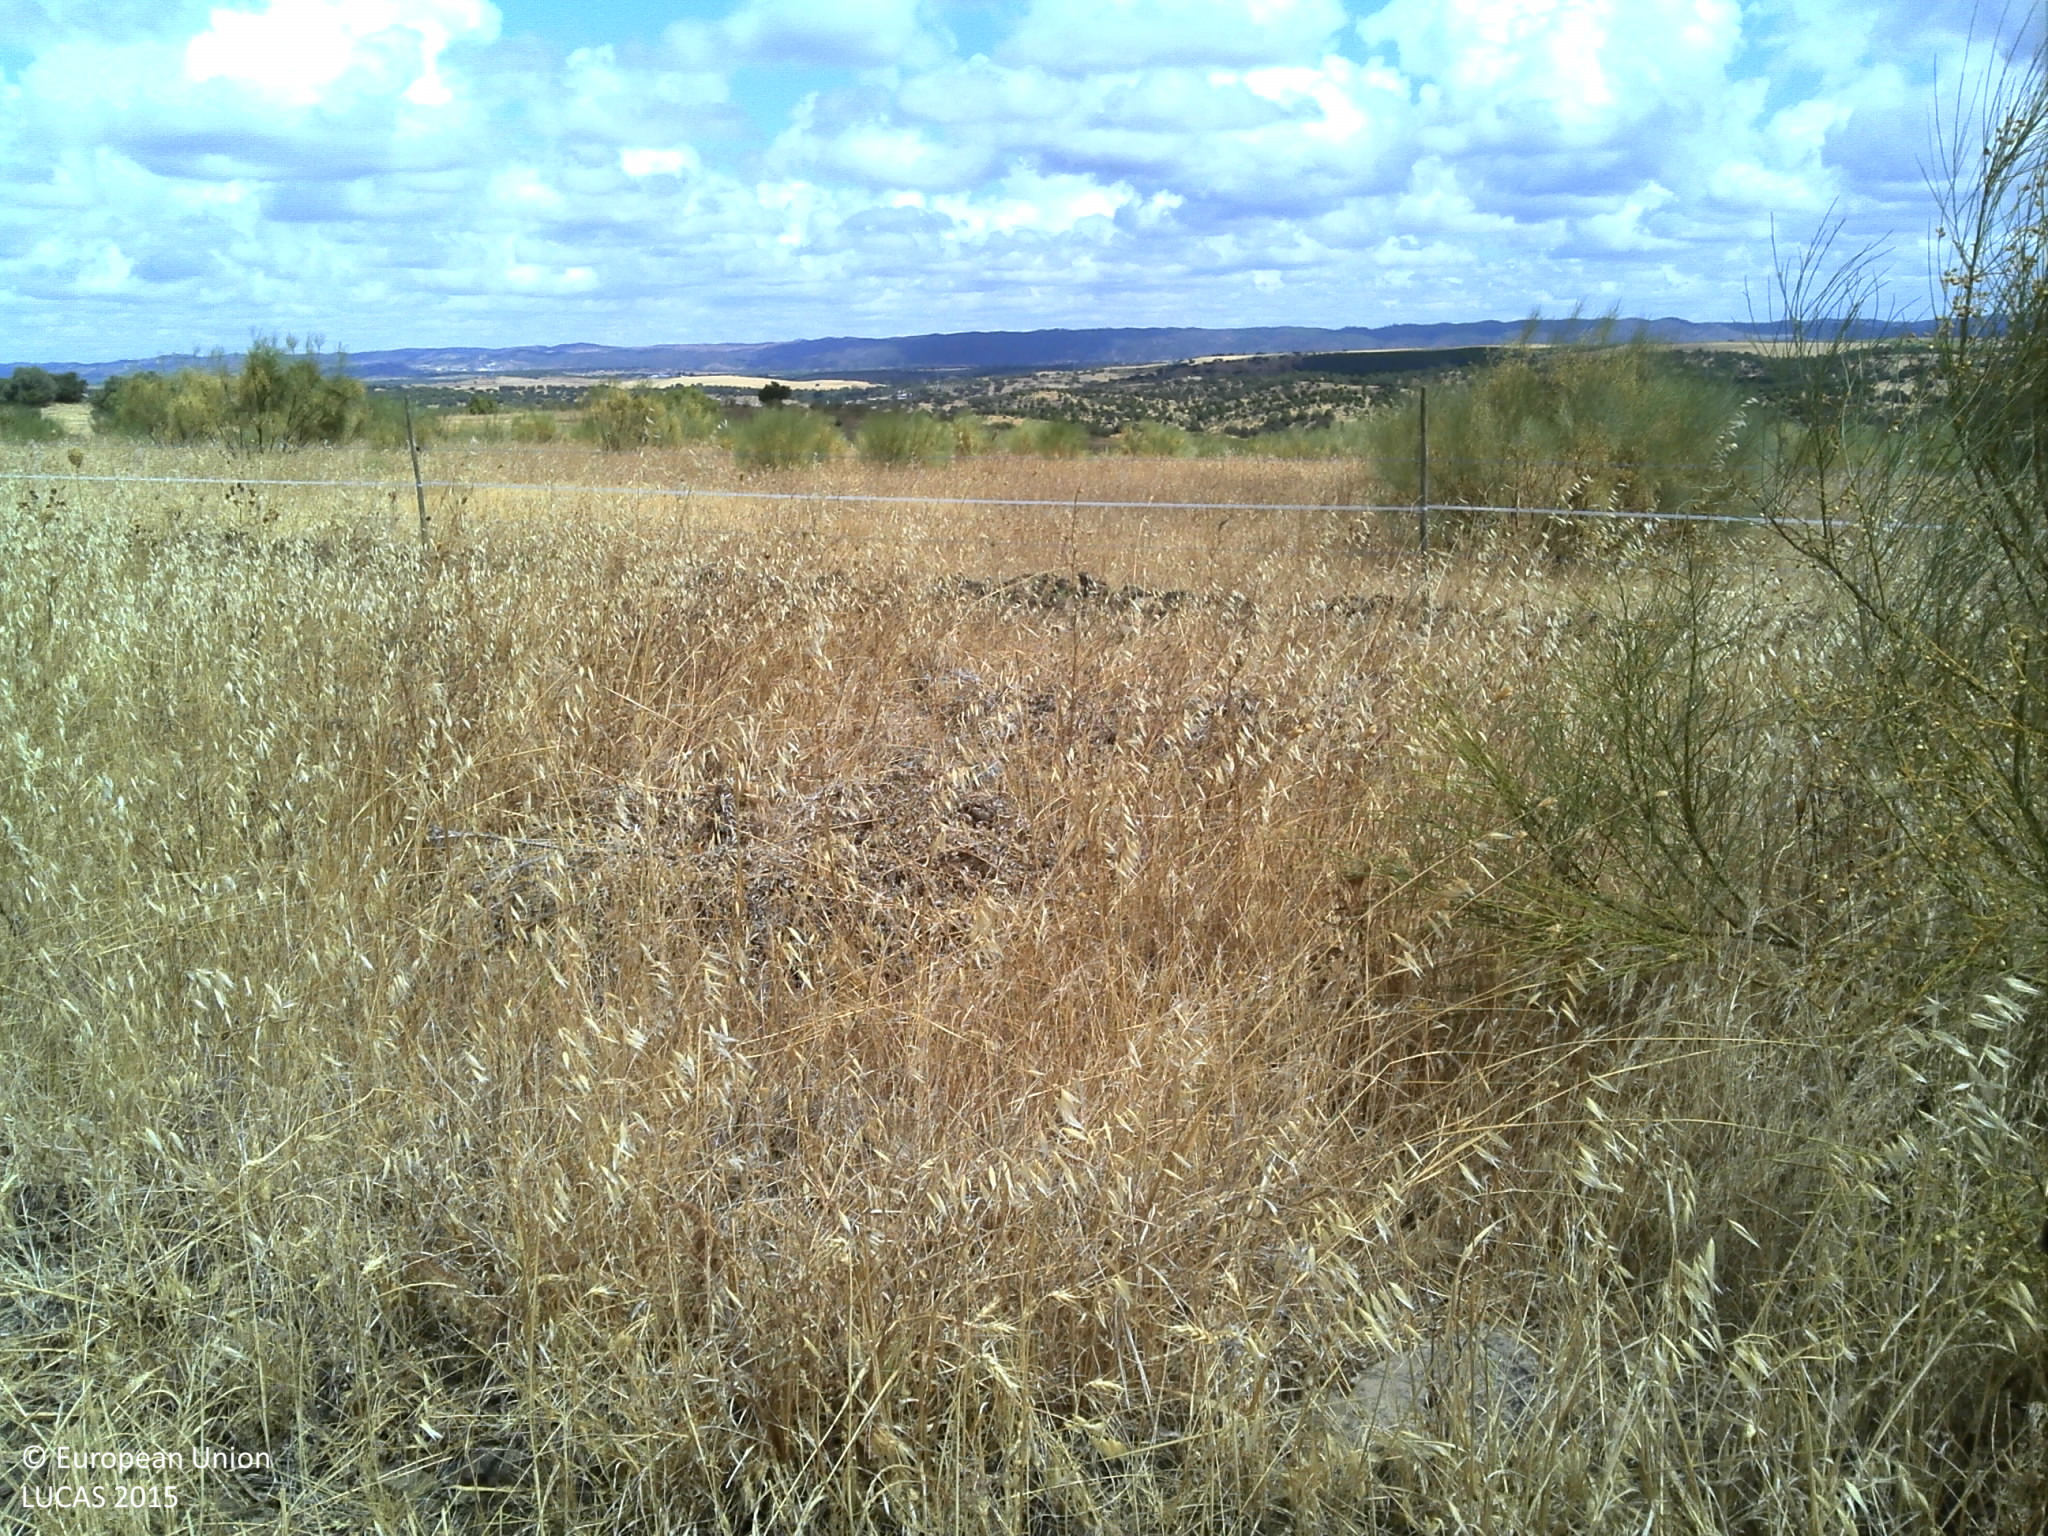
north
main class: Cropland
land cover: Common wheat
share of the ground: > 75 %
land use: Agriculture (excluding fallow land and kitchen gardens)
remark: Harvested field
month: July
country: PT
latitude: 38.1049
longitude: -7.7140
